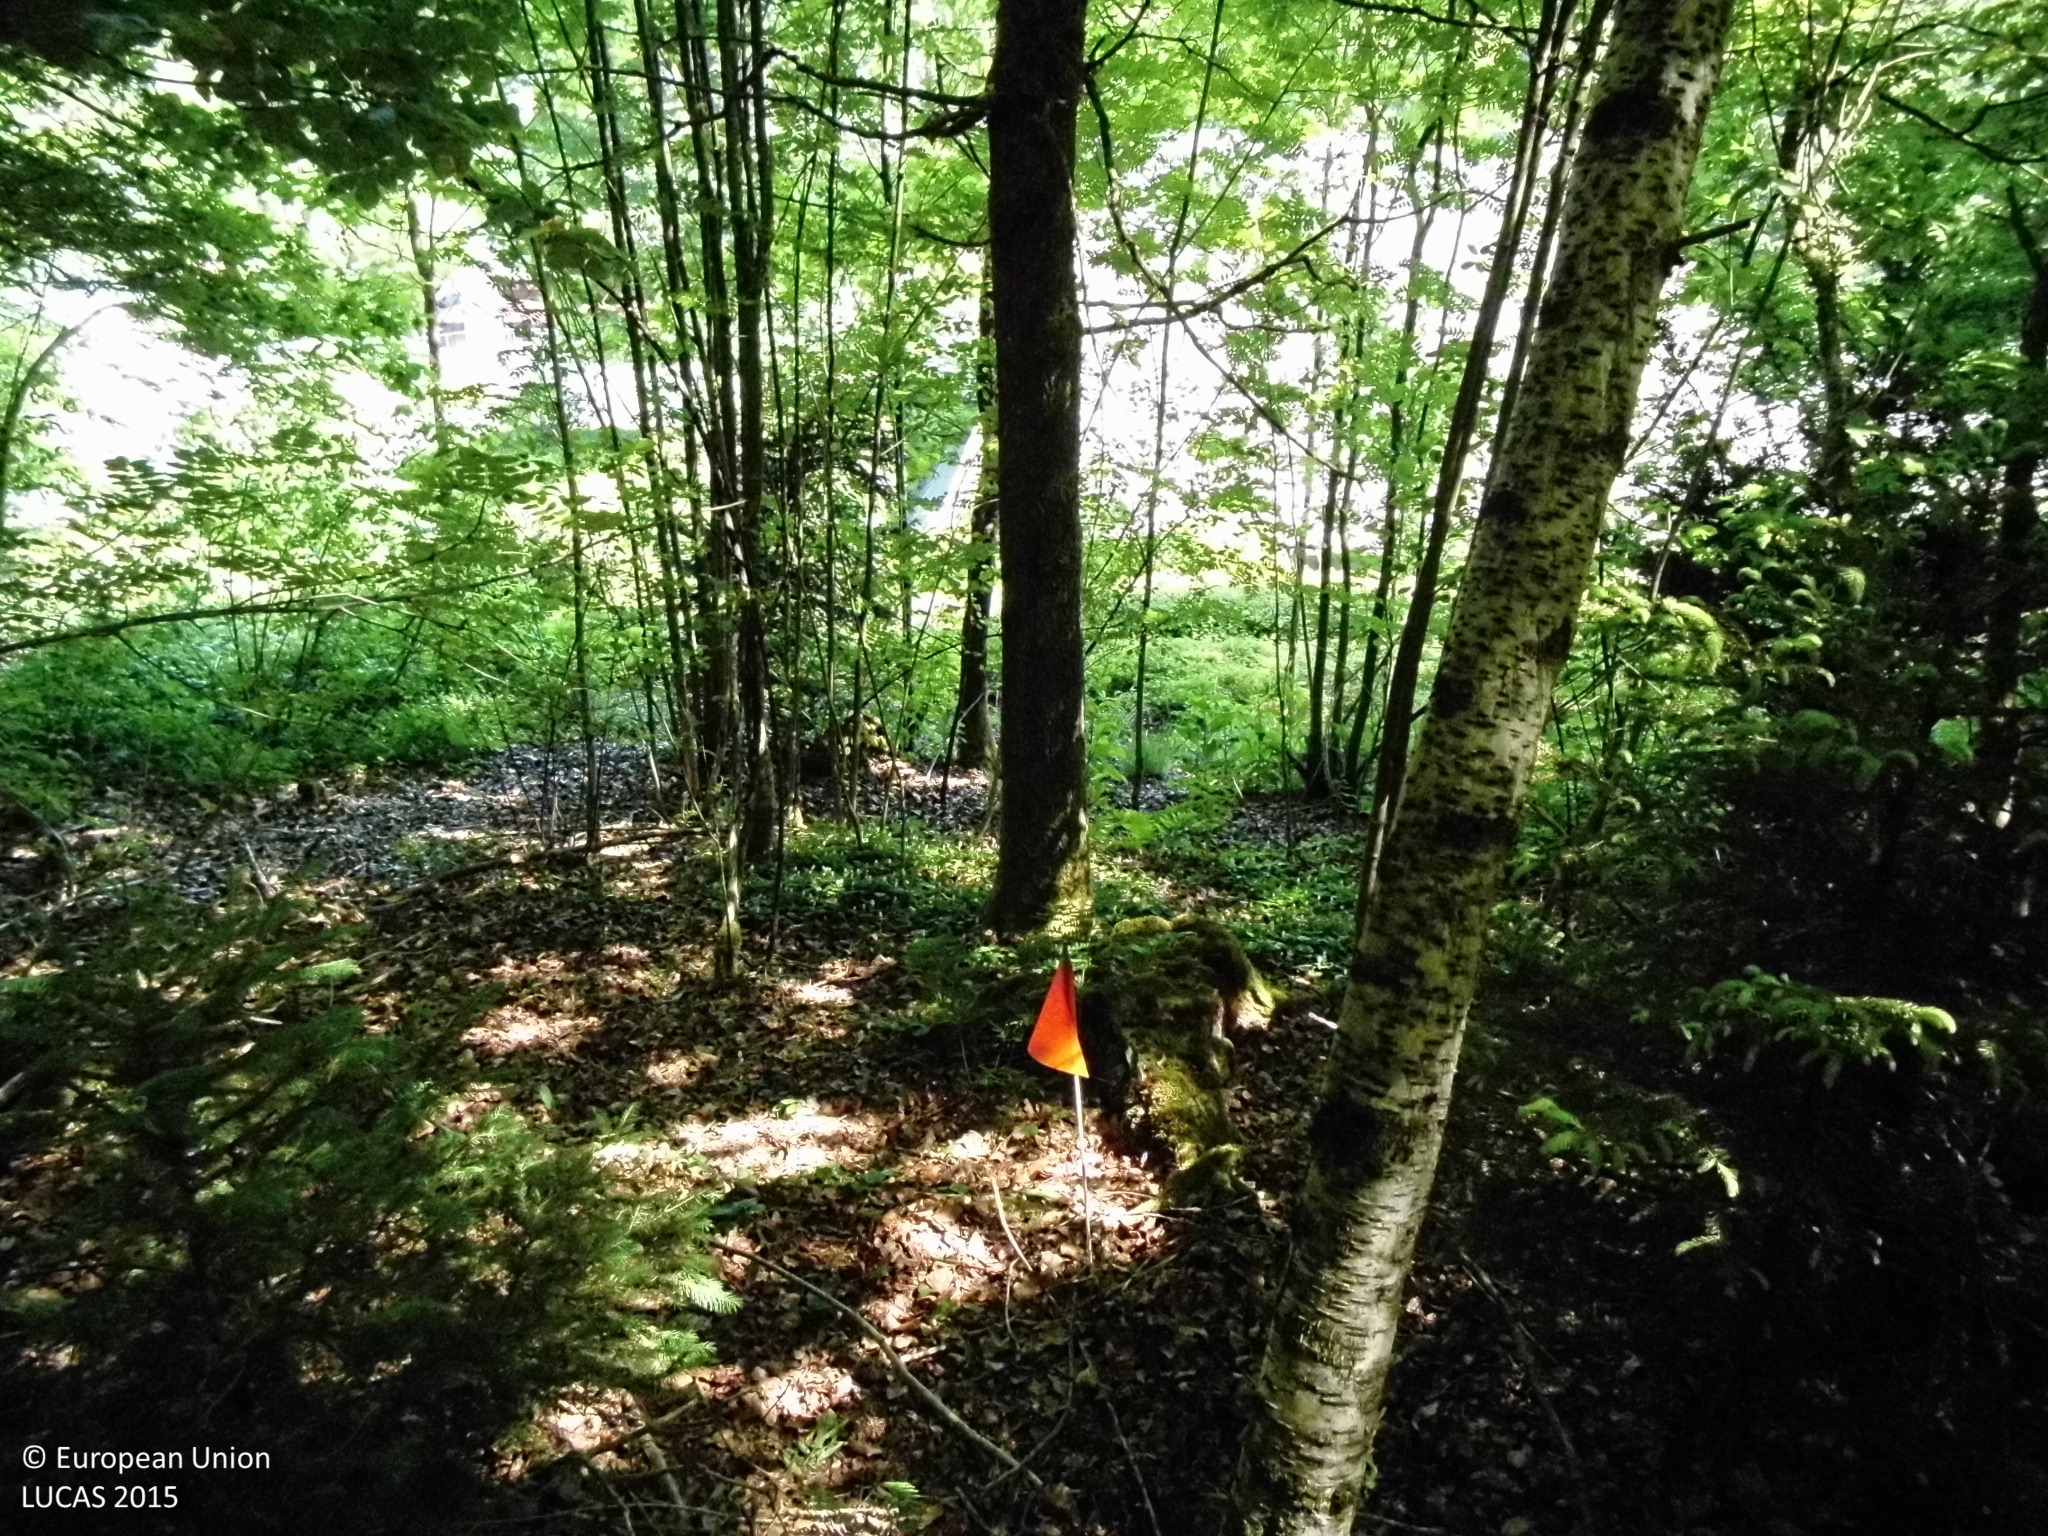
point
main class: Woodland
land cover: Broadleaved woodland
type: mesophytic deciduous forest
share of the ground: > 75 %
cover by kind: broadleaved forest trees 85 %, coniferous forest trees 15 %
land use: Forestry
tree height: > 5 m
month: June
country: DE
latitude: 50.9220
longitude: 7.9945
